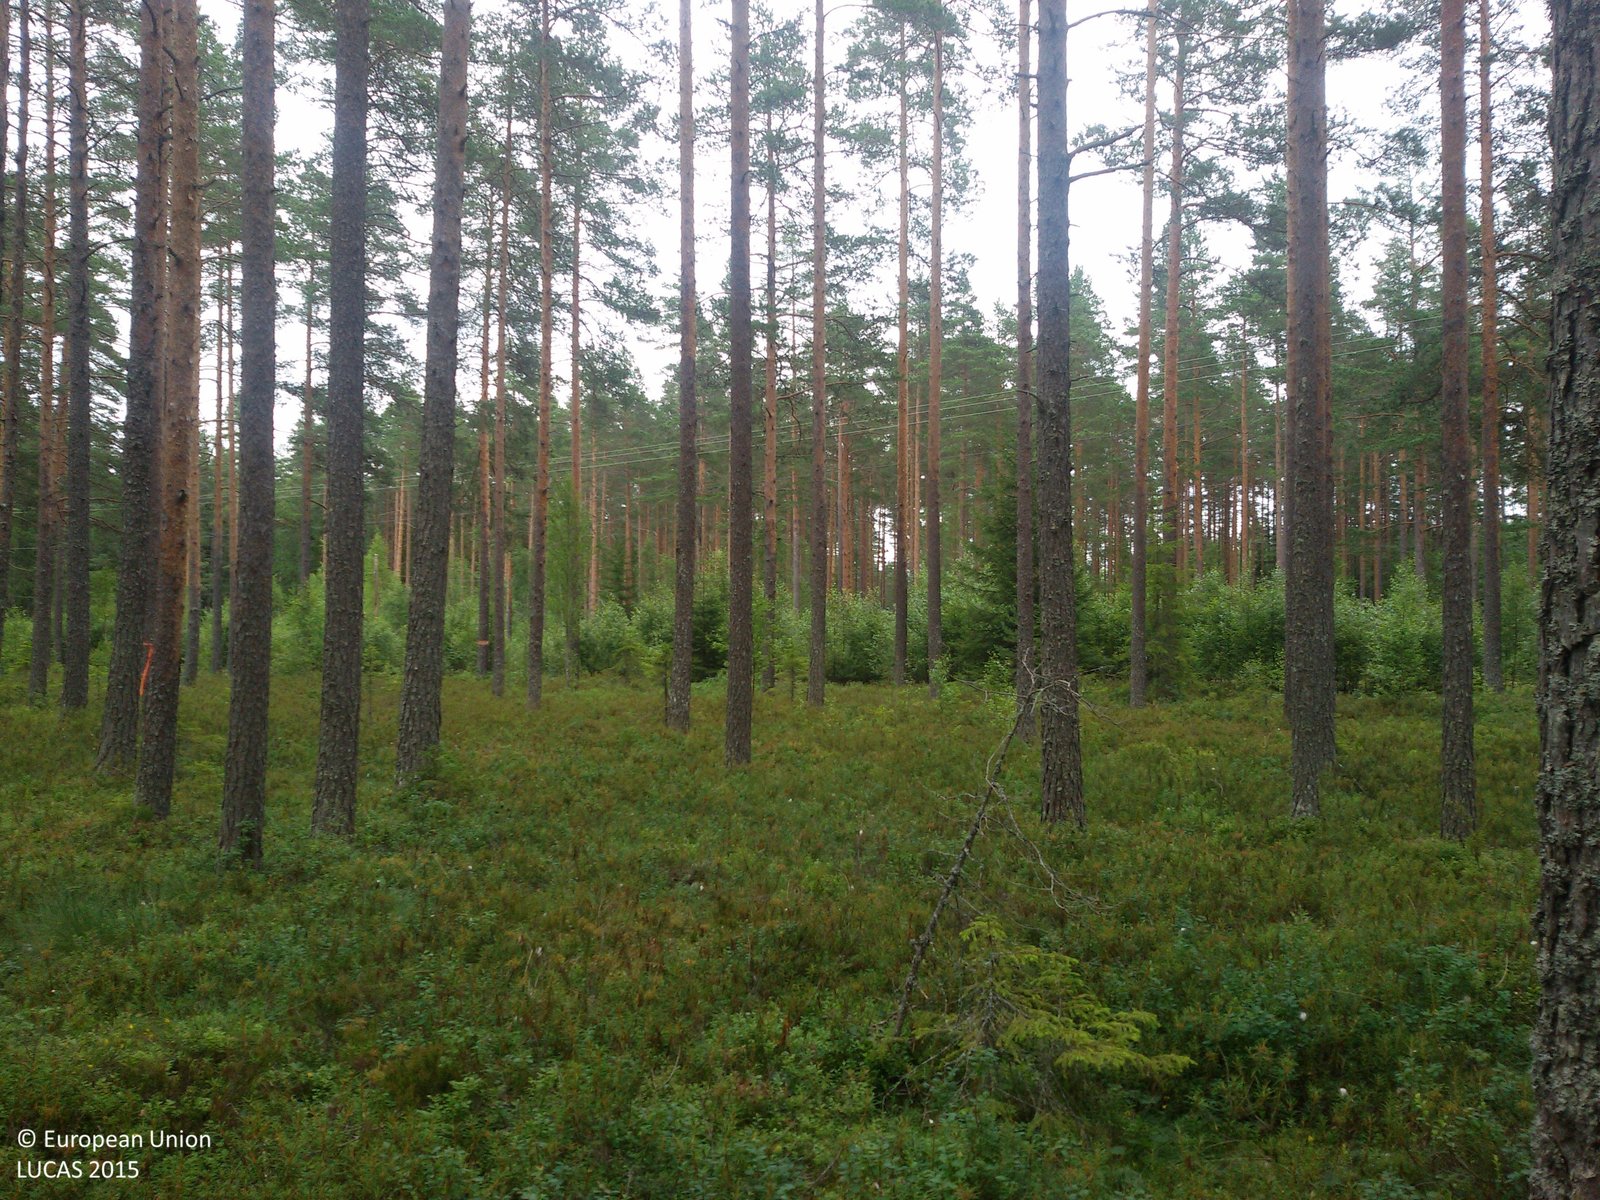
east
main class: Woodland
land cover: Pine dominated coniferous woodland
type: boreal forest
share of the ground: 50 - 75 %
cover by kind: coniferous forest trees 70 %, shrubs 20 %, lichens and mosses 10 %
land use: Forestry
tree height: > 5 m
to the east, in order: Pine dominated coniferous woodland; Electric lines; Broadleaved woodland; Ditches and canals; Artificial constructions in urban areas; Ditches and canals; Electric lines; Pine dominated coniferous woodland; Rivers and streams; Pine dominated coniferous woodland; Spruce dominated coniferous woodland
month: August
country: SE
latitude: 60.7291
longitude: 16.6434
